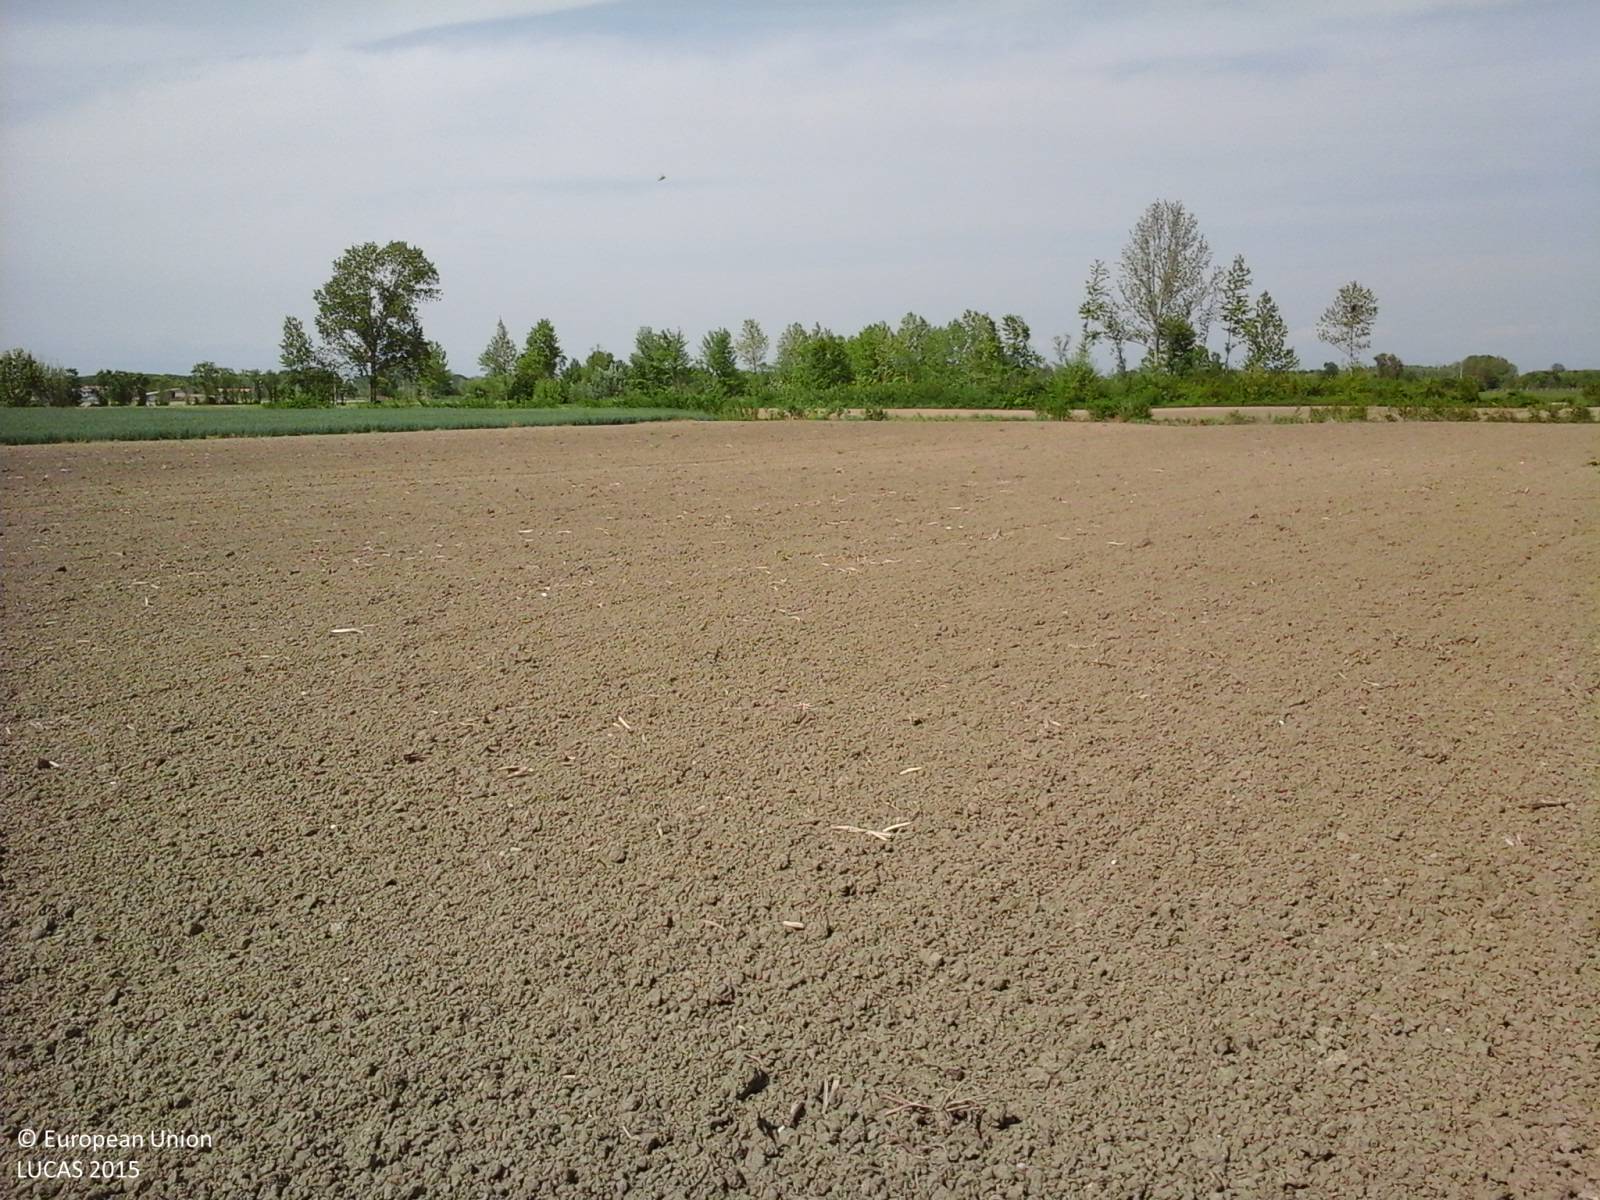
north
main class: Cropland
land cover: Soya
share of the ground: < 10 %
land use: Agriculture (excluding fallow land and kitchen gardens)
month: May
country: IT
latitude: 45.8391
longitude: 13.0476
